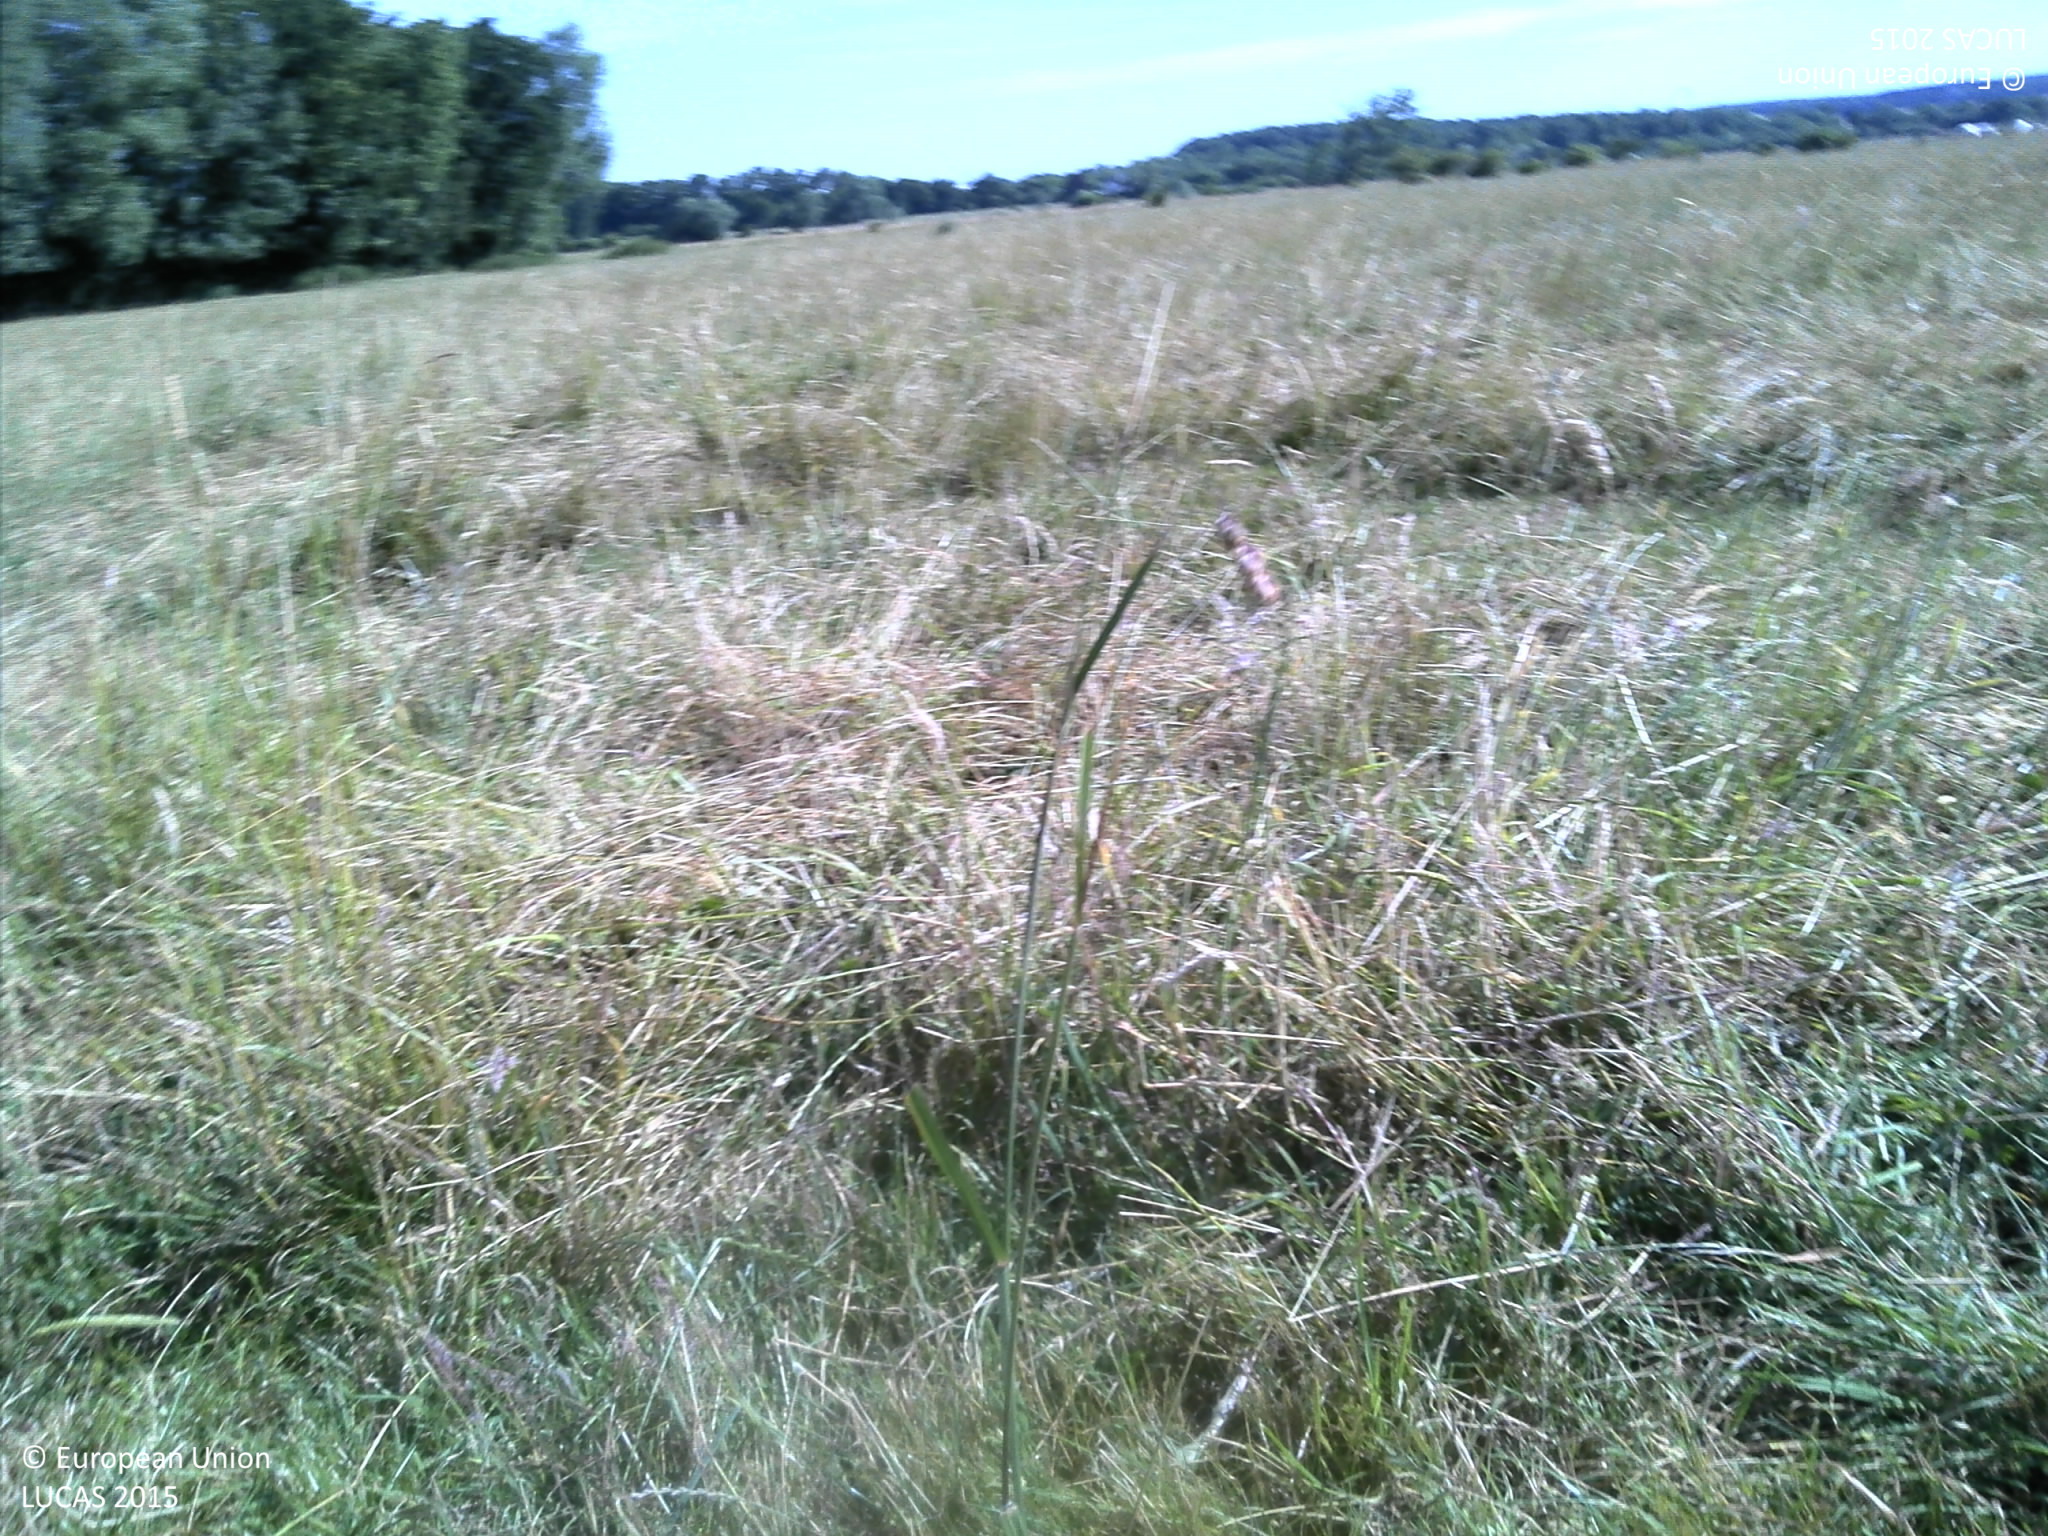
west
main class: Grassland
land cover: Grassland without tree/shrub cover
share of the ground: > 75 %
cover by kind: herbaceous plants 100 %
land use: Agriculture (excluding fallow land and kitchen gardens)
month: June
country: FR
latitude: 49.3473
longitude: 6.2142
